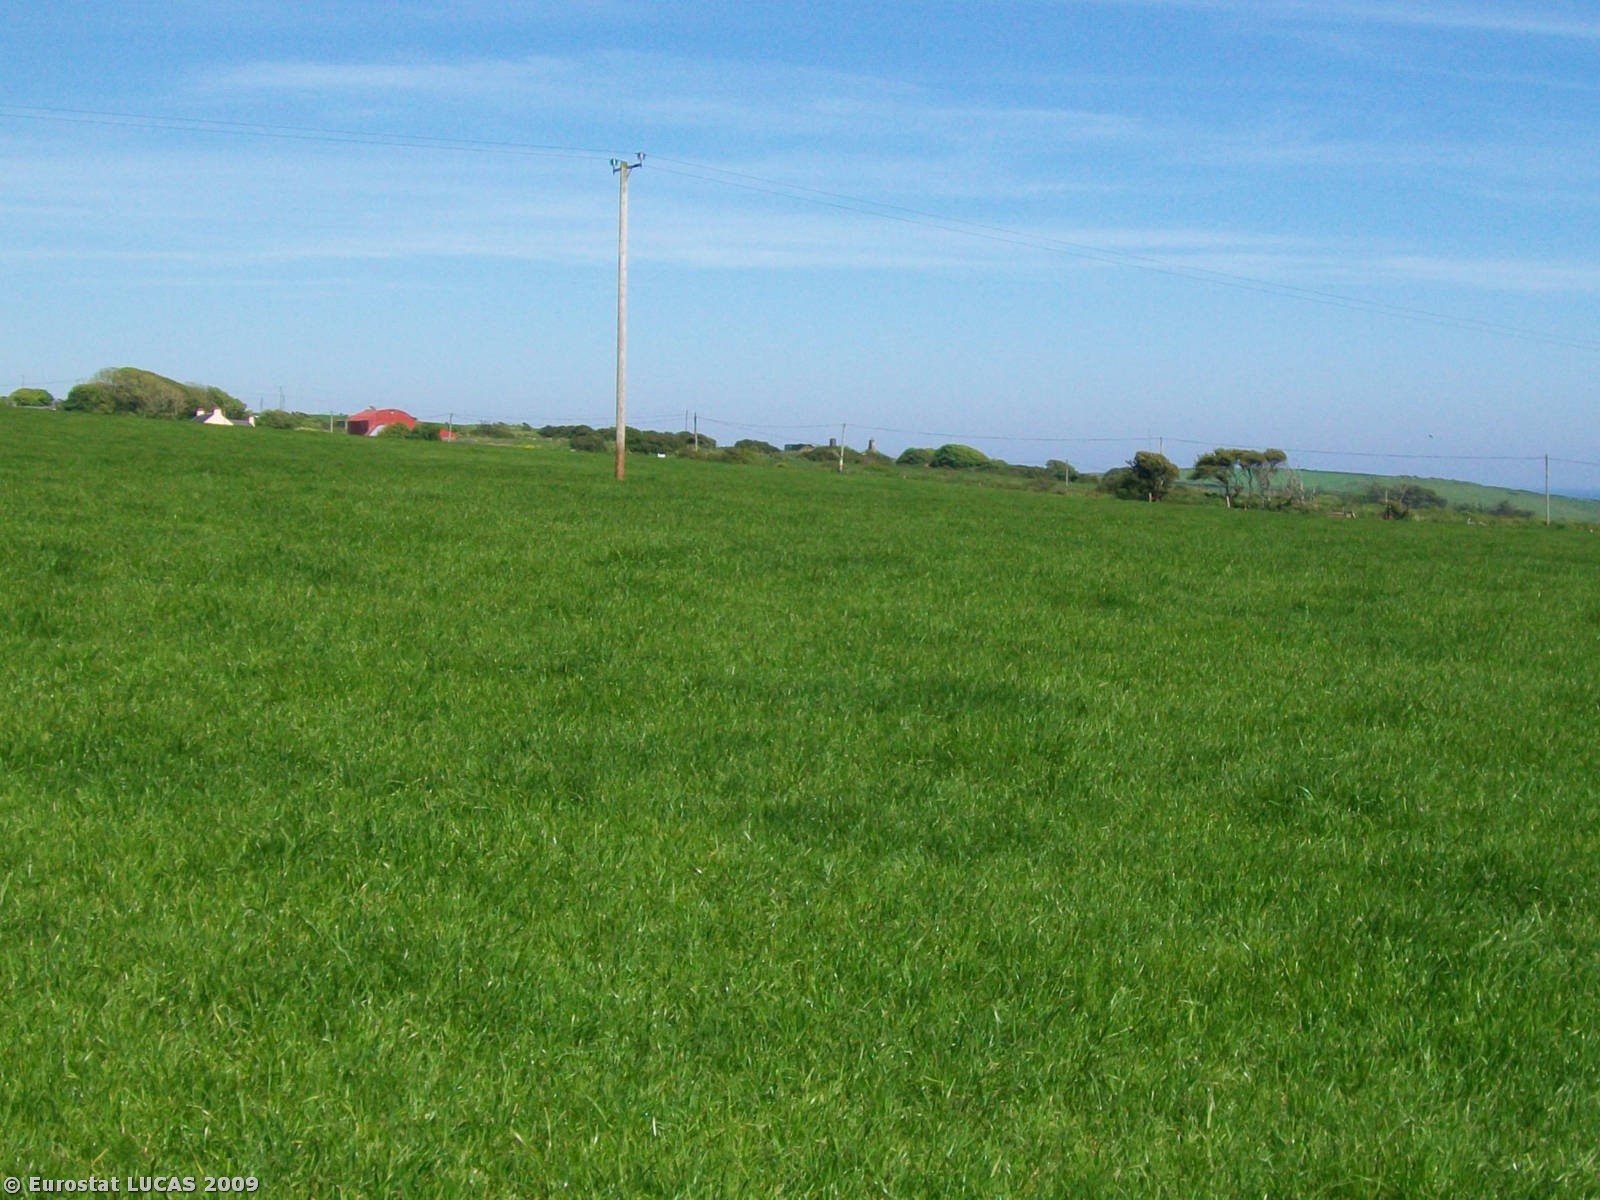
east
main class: Grassland
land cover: Grassland without tree/shrub cover
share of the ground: > 75 %
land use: Agriculture (excluding fallow land and kitchen gardens)
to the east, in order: Grassland without tree/shrub cover; Managed hedges; Grassland without tree/shrub cover; Managed hedges; Paved roads, cycling and walking lanes; Managed hedges; Grassland without tree/shrub cover
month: July
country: IE
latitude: 52.5262
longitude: -7.6907
